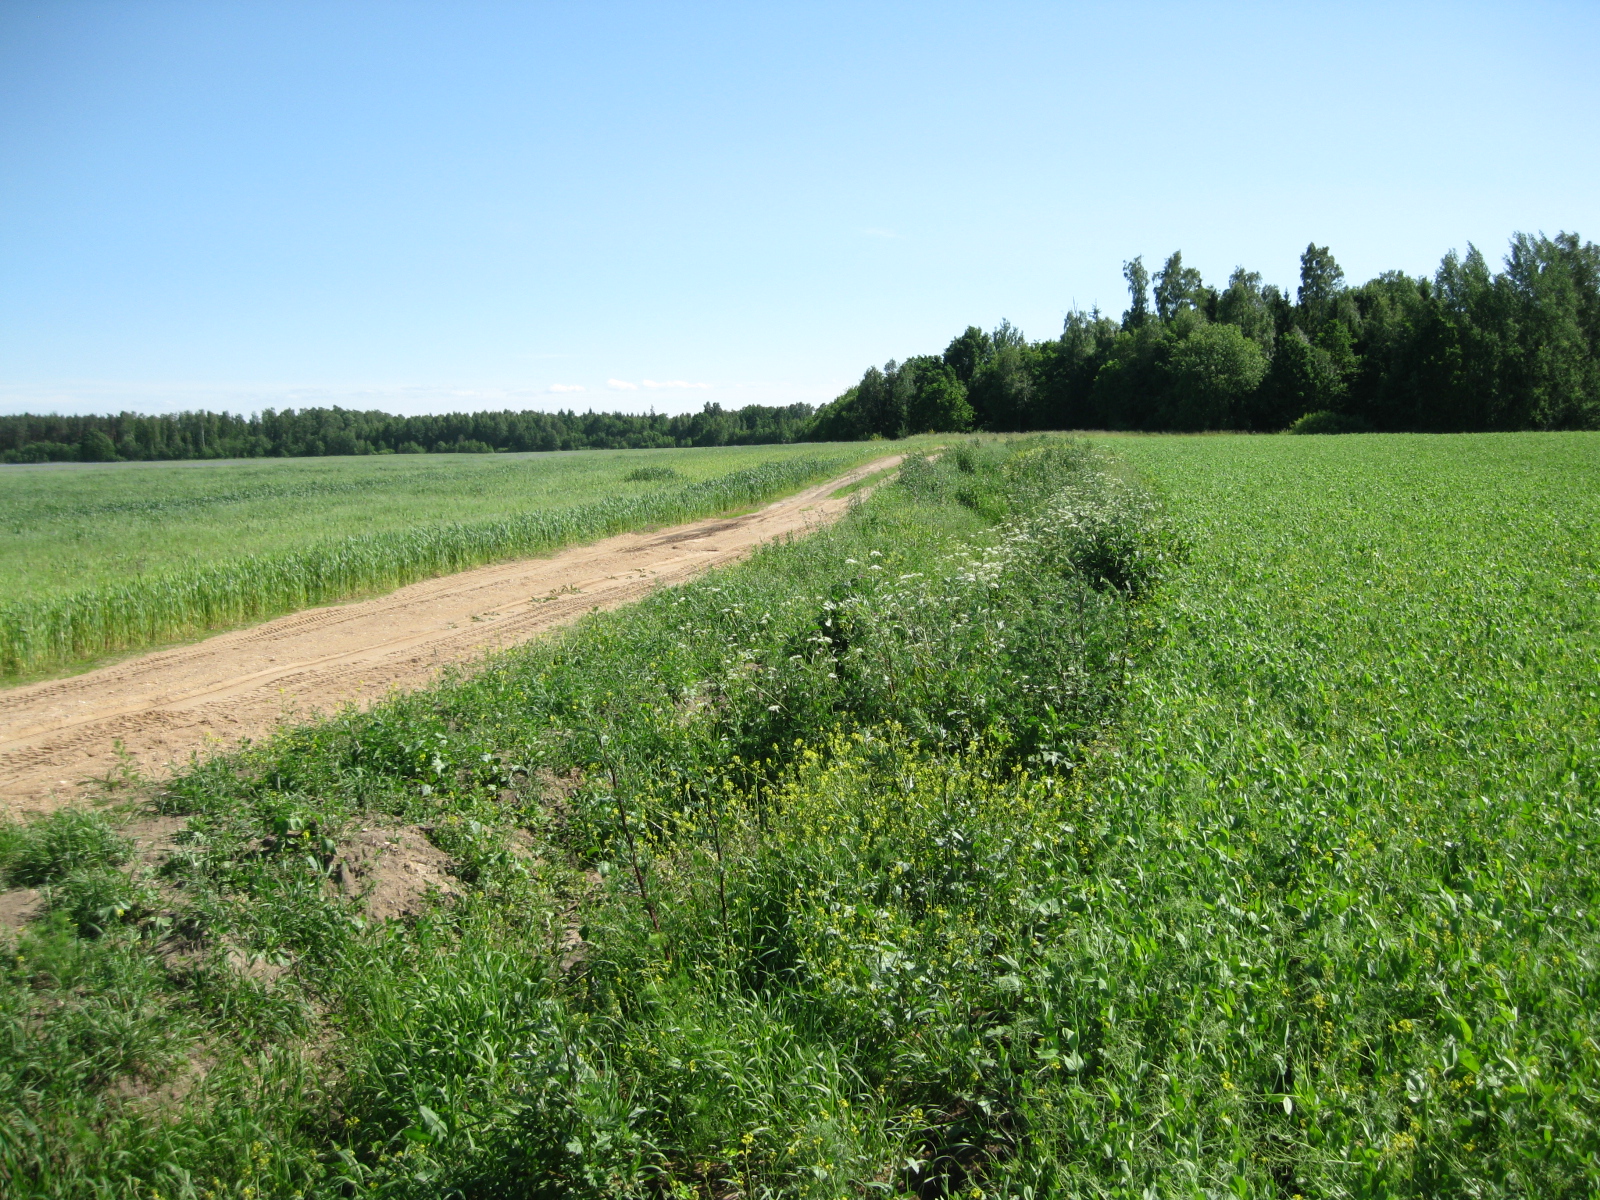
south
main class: Cropland
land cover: Dry pulses
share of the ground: > 75 %
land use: Agriculture (excluding fallow land and kitchen gardens)
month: June
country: LT
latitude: 55.2801
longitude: 23.7336
